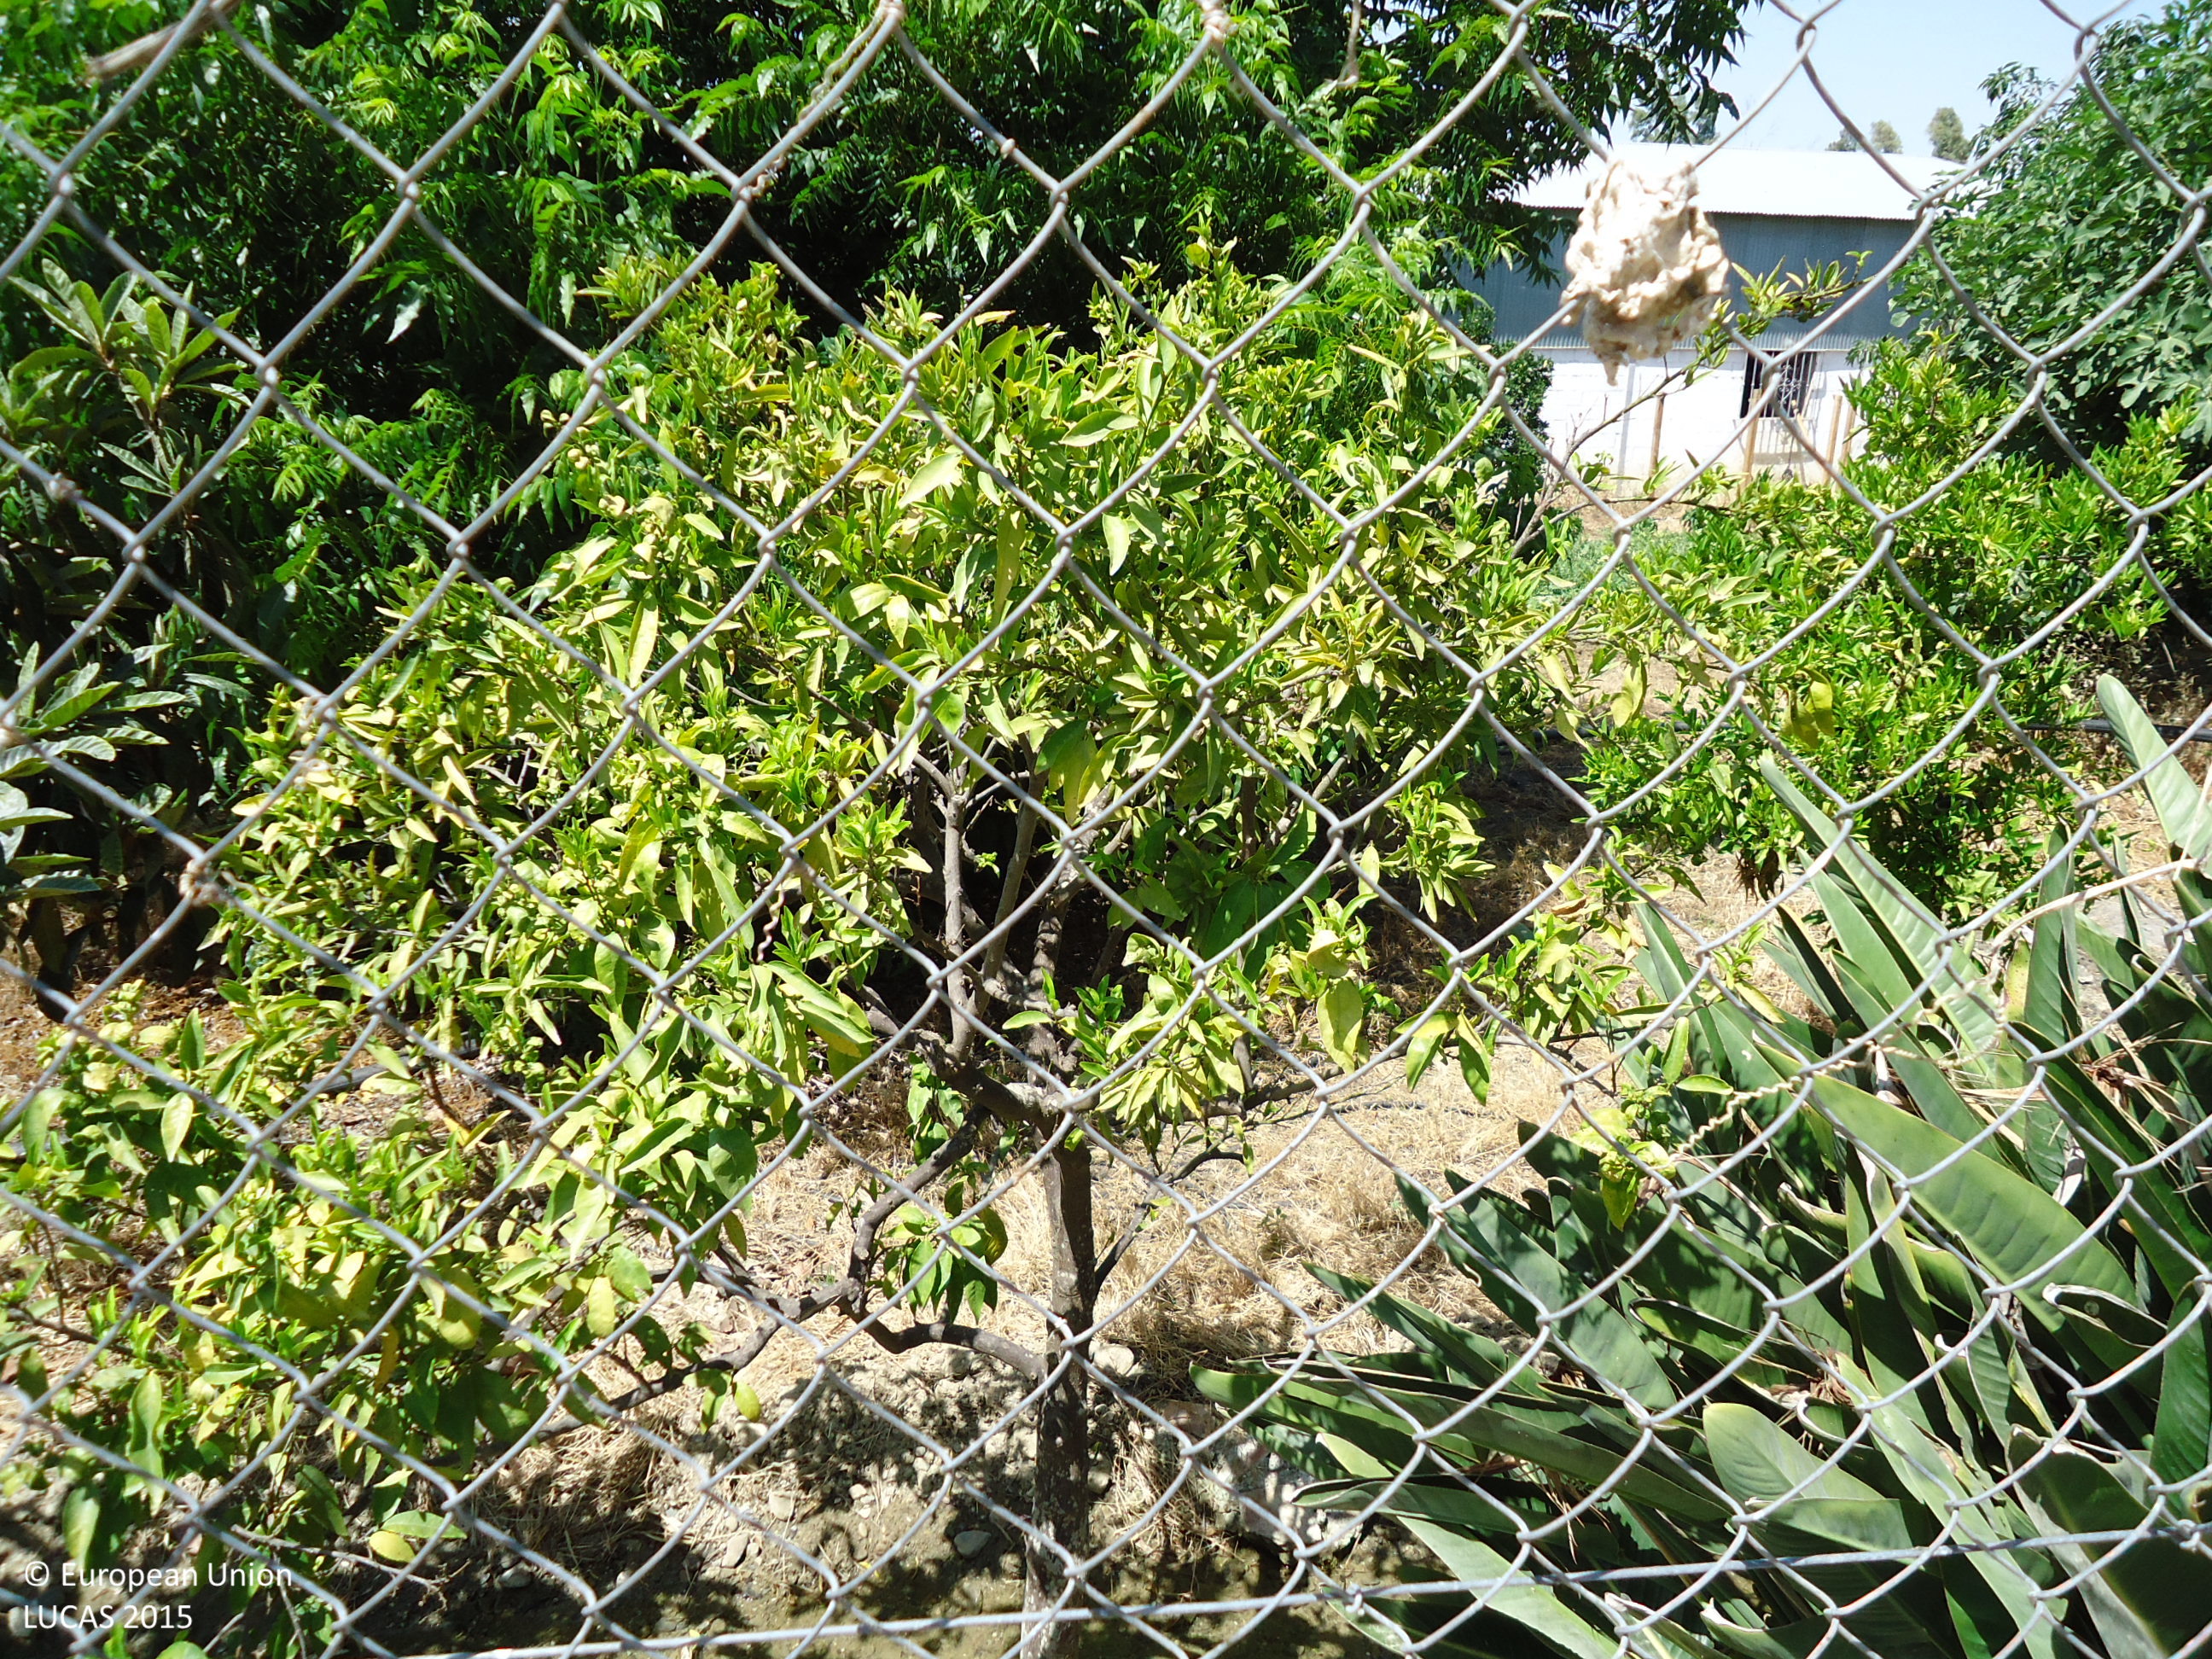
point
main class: Cropland
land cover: Oranges
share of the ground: 25 - 50 %
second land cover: Spontaneously vegetated surfaces
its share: > 75 %
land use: Agriculture (excluding fallow land and kitchen gardens)
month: June
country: ES
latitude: 36.6998
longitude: -4.7571
